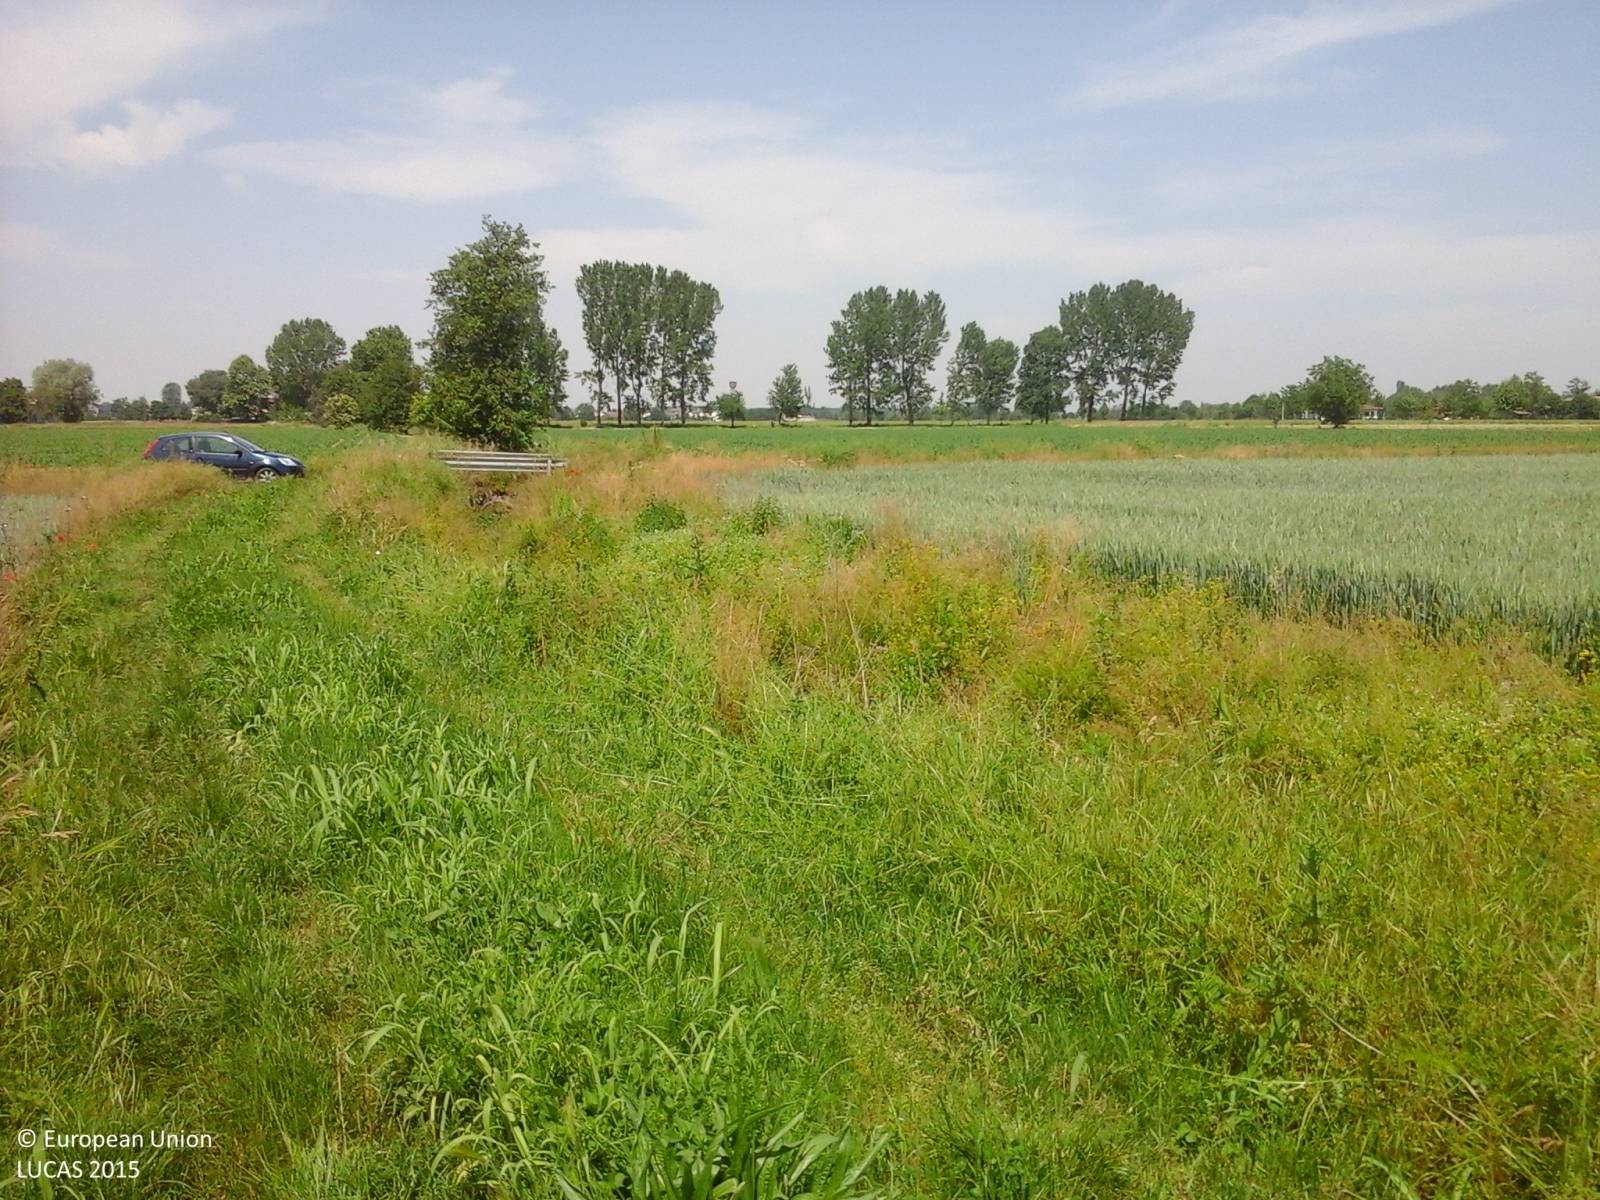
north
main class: Cropland
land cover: Common wheat
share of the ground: > 75 %
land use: Agriculture (excluding fallow land and kitchen gardens)
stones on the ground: 10 - 25 %
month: May
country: IT
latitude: 45.2678
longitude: 9.3003
